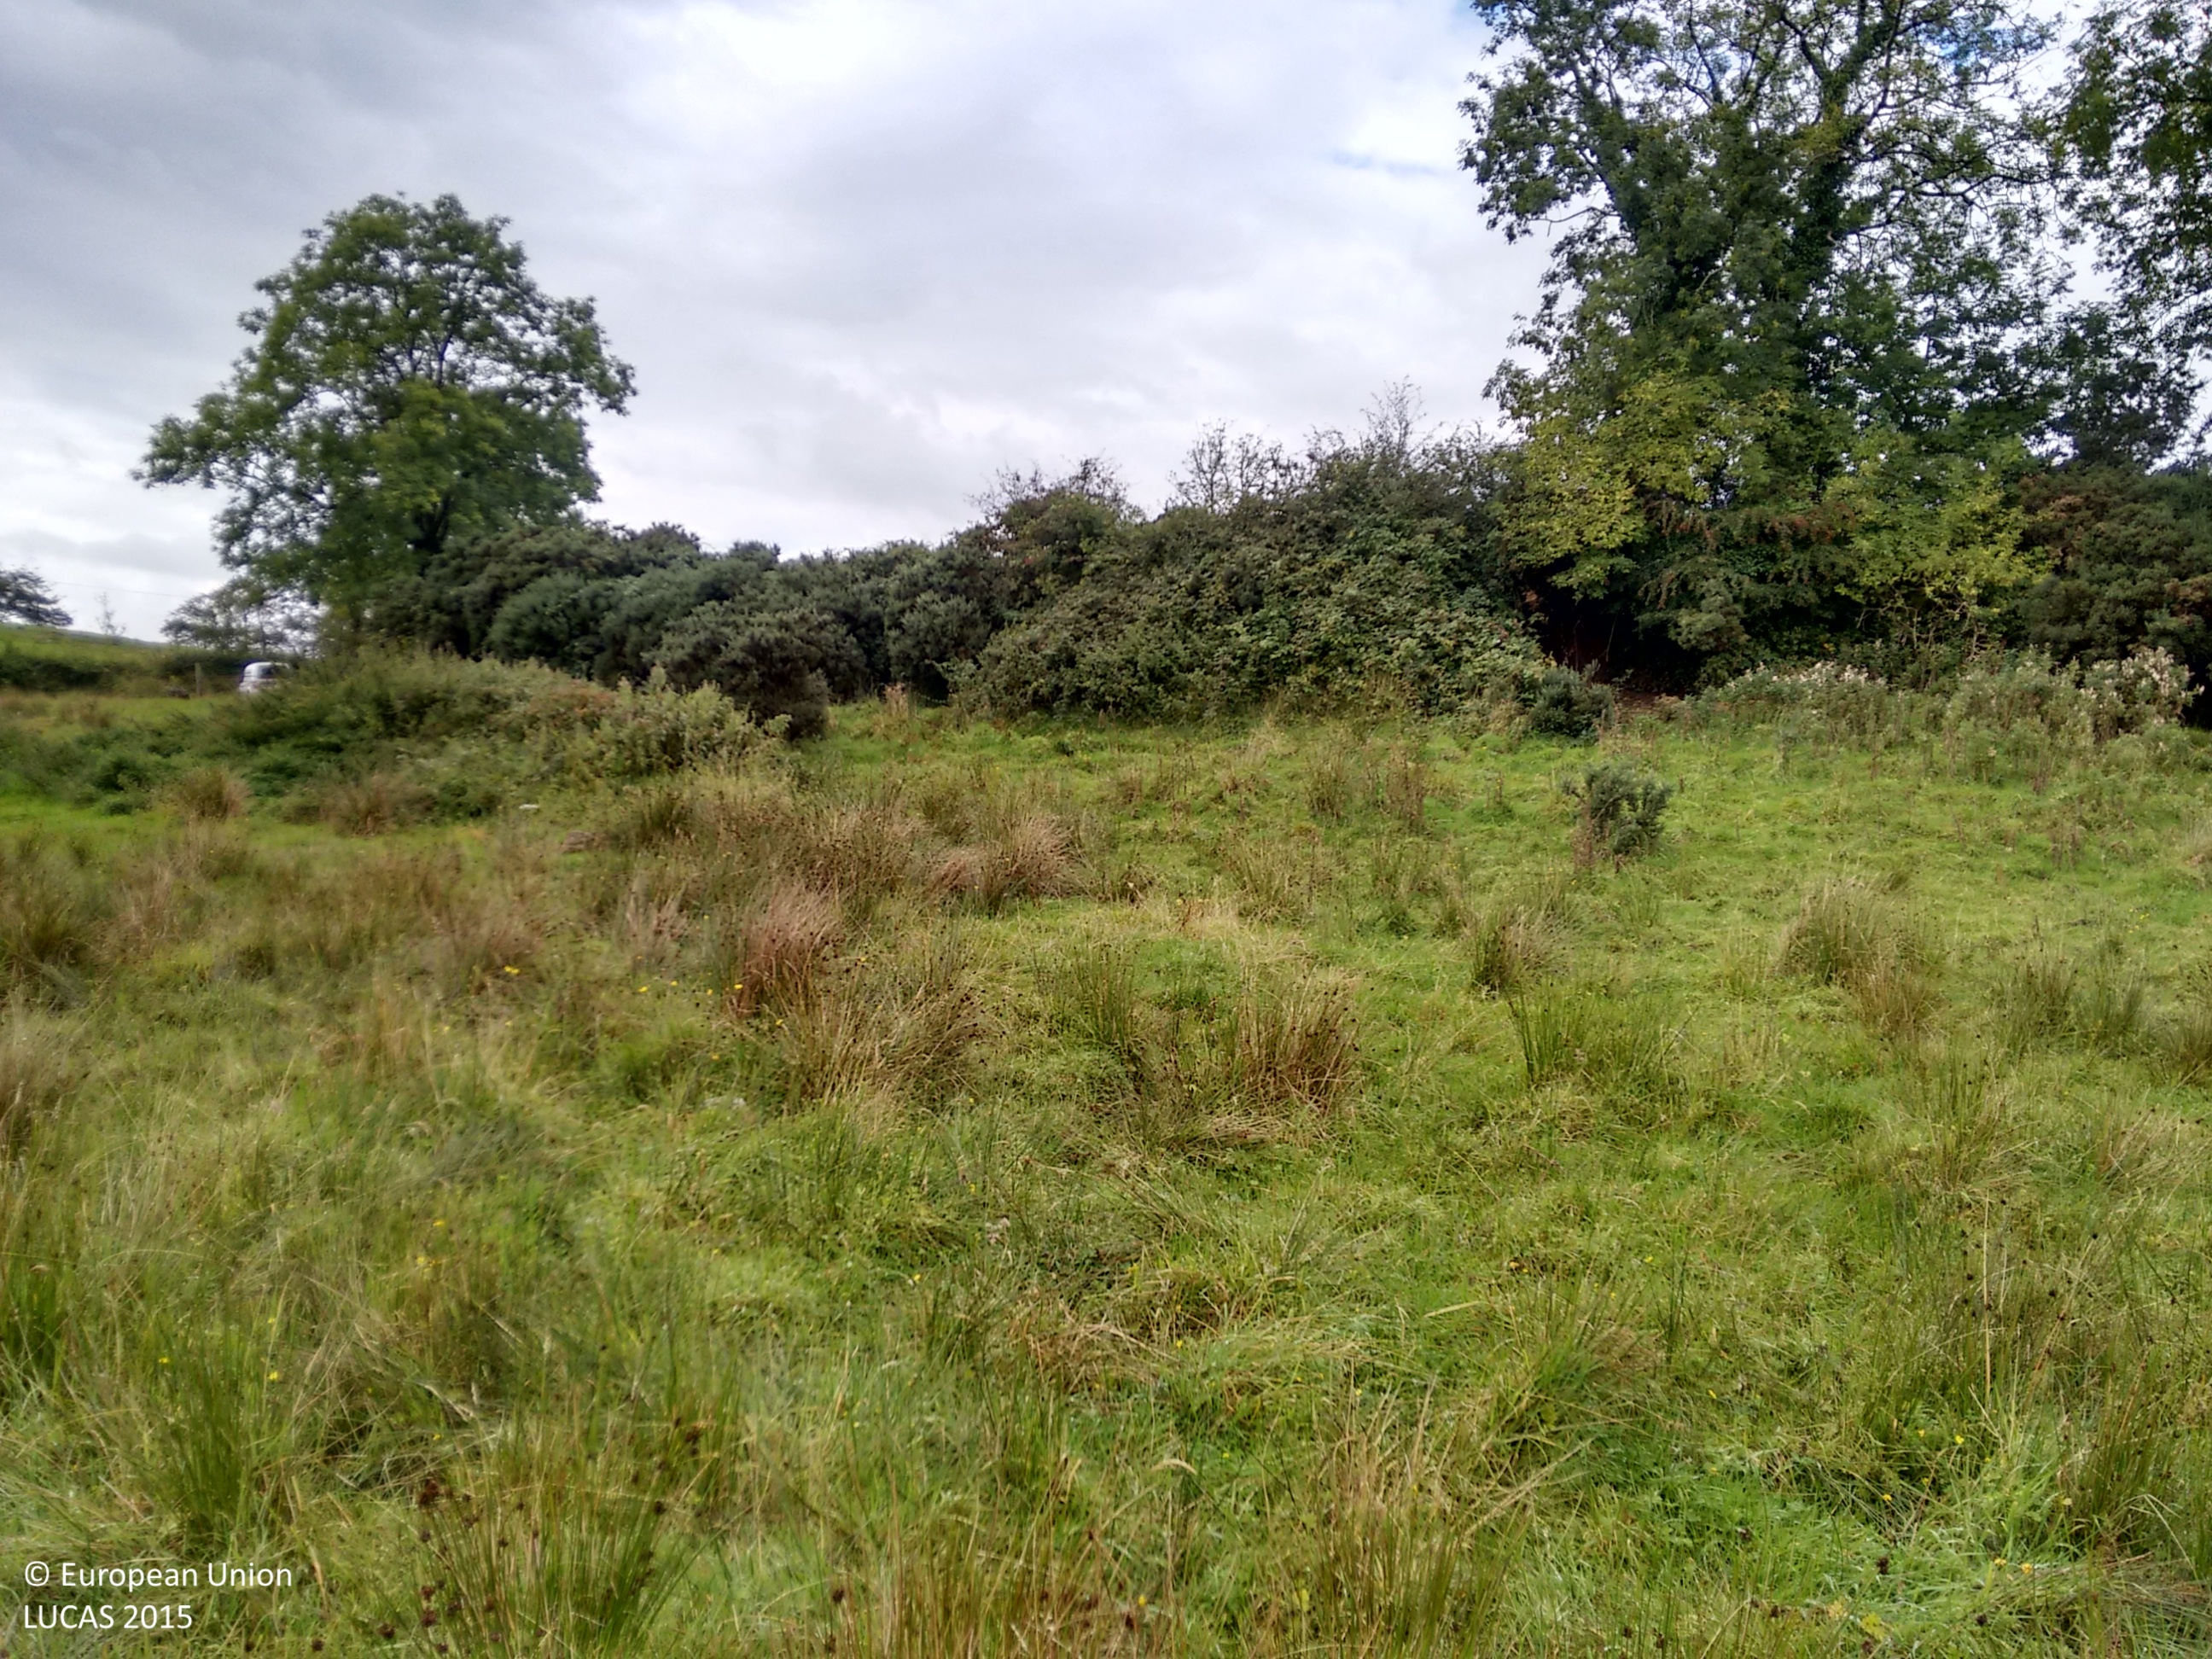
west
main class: Grassland
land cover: Grassland without tree/shrub cover
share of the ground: > 75 %
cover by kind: herbaceous plants 95 %
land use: Agriculture (excluding fallow land and kitchen gardens)
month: September
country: IE
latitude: 52.8943
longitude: -8.7695
